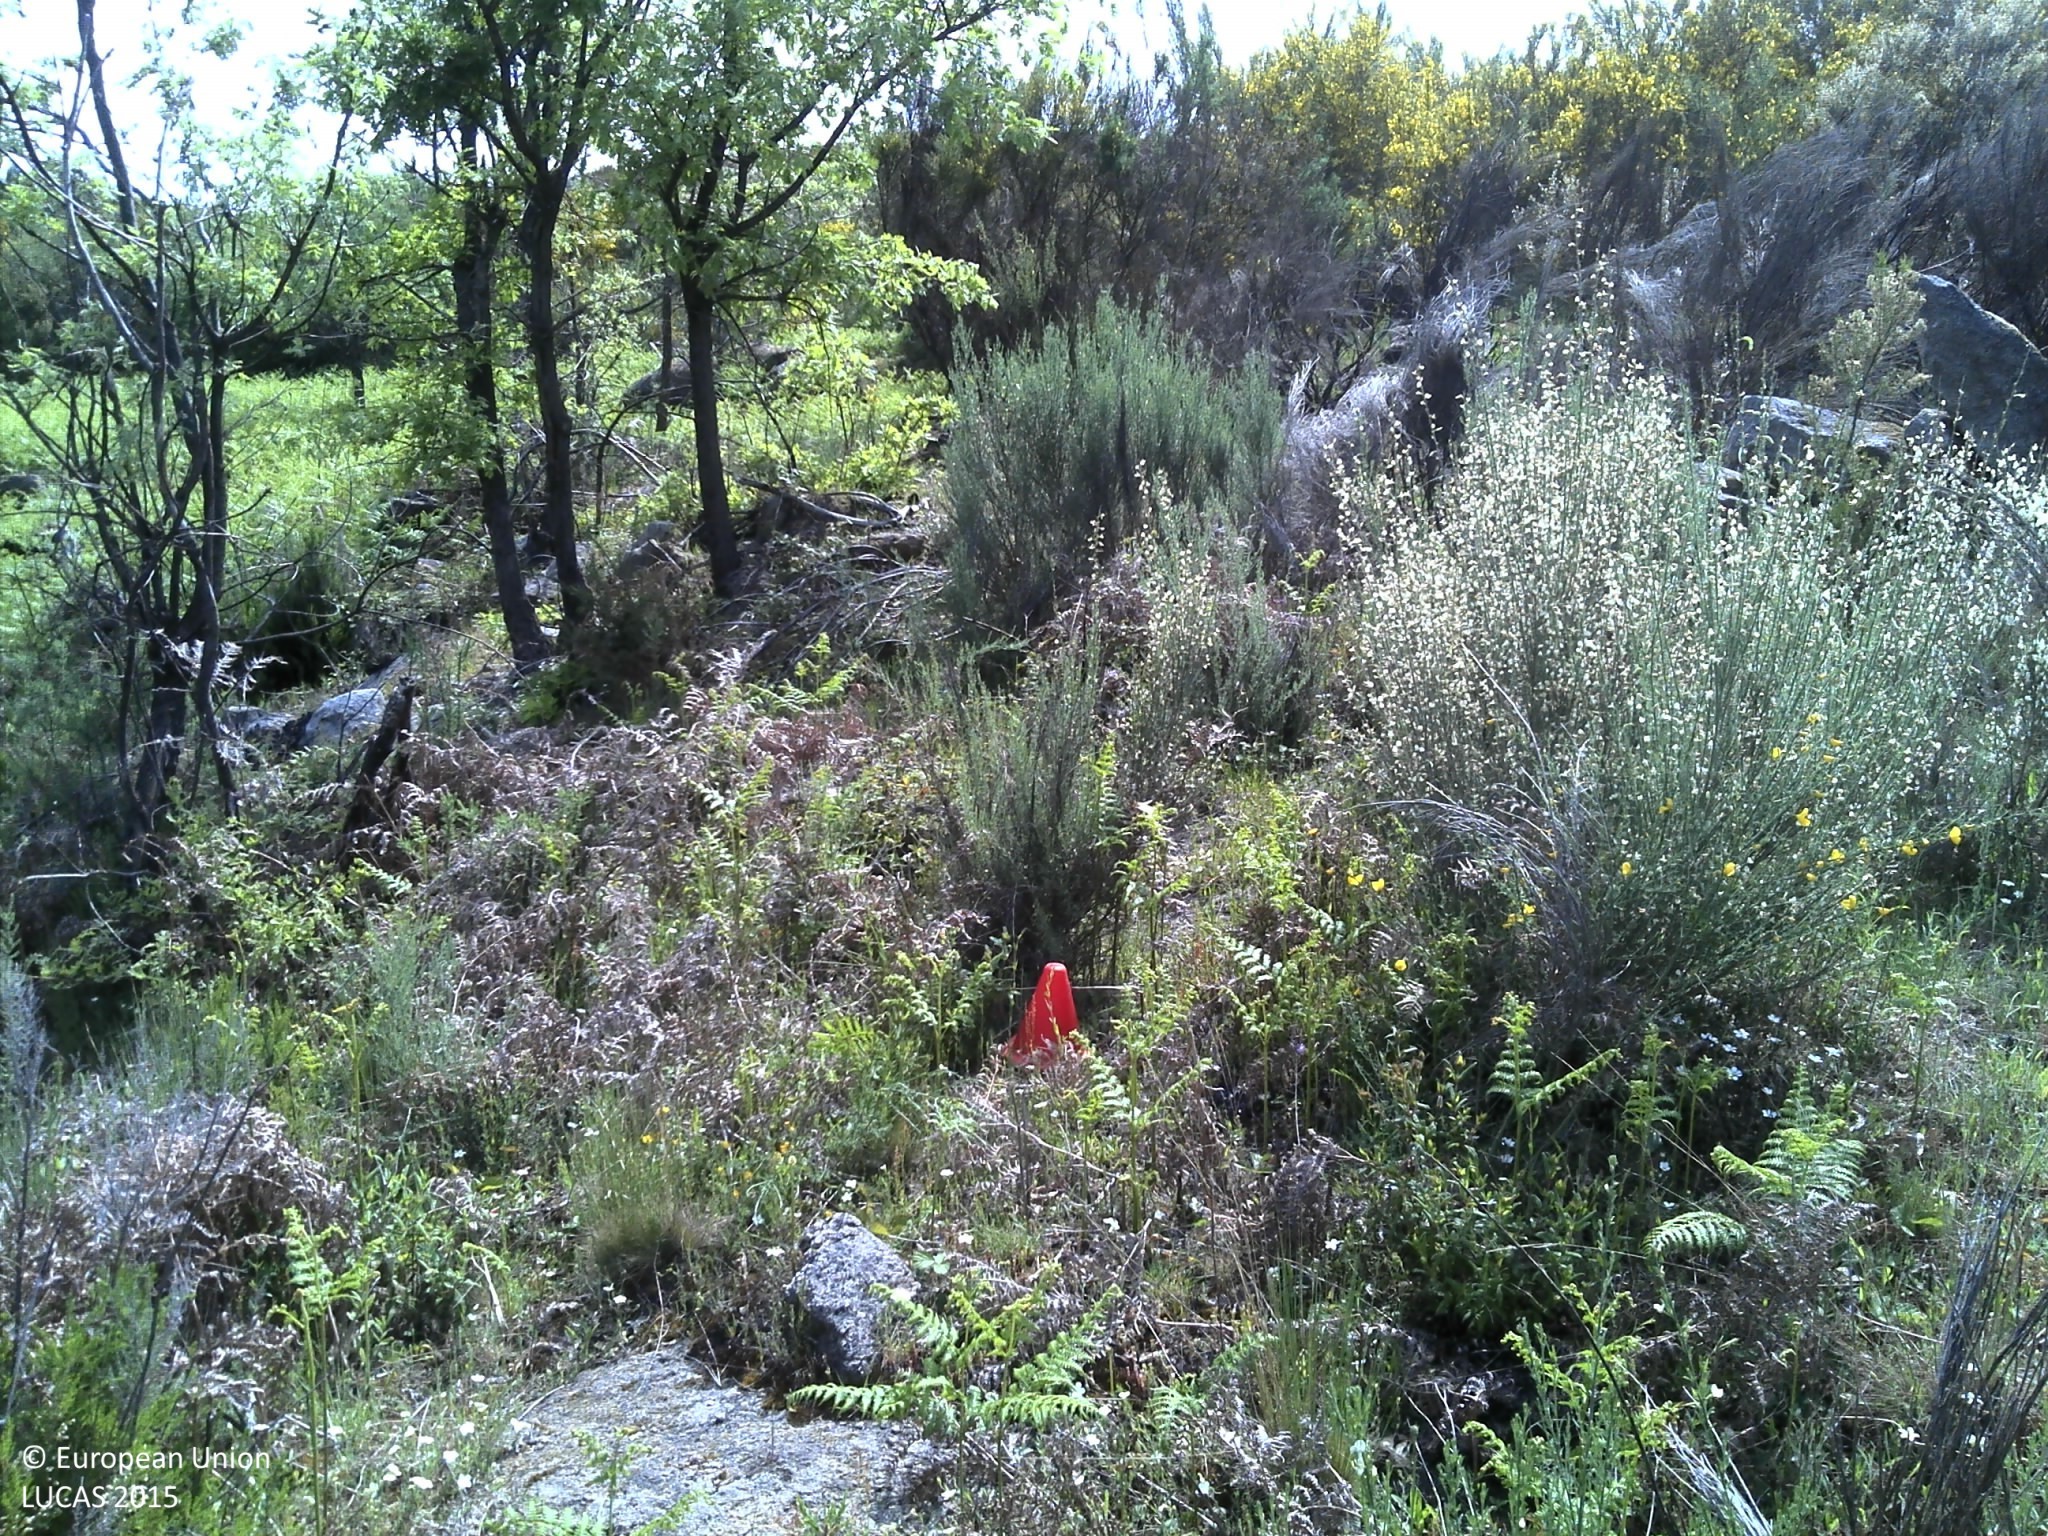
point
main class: Shrubland
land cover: Shrubland with sparse tree cover
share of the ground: 50 - 75 %
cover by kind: shrubs 70 %, unconsolidated bare surface 15 %, herbaceous plants 10 %, broadleaved forest trees 5 %
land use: Forestry
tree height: < 5 m
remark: Burnt area
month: May
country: PT
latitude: 41.9608
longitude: -7.0999
